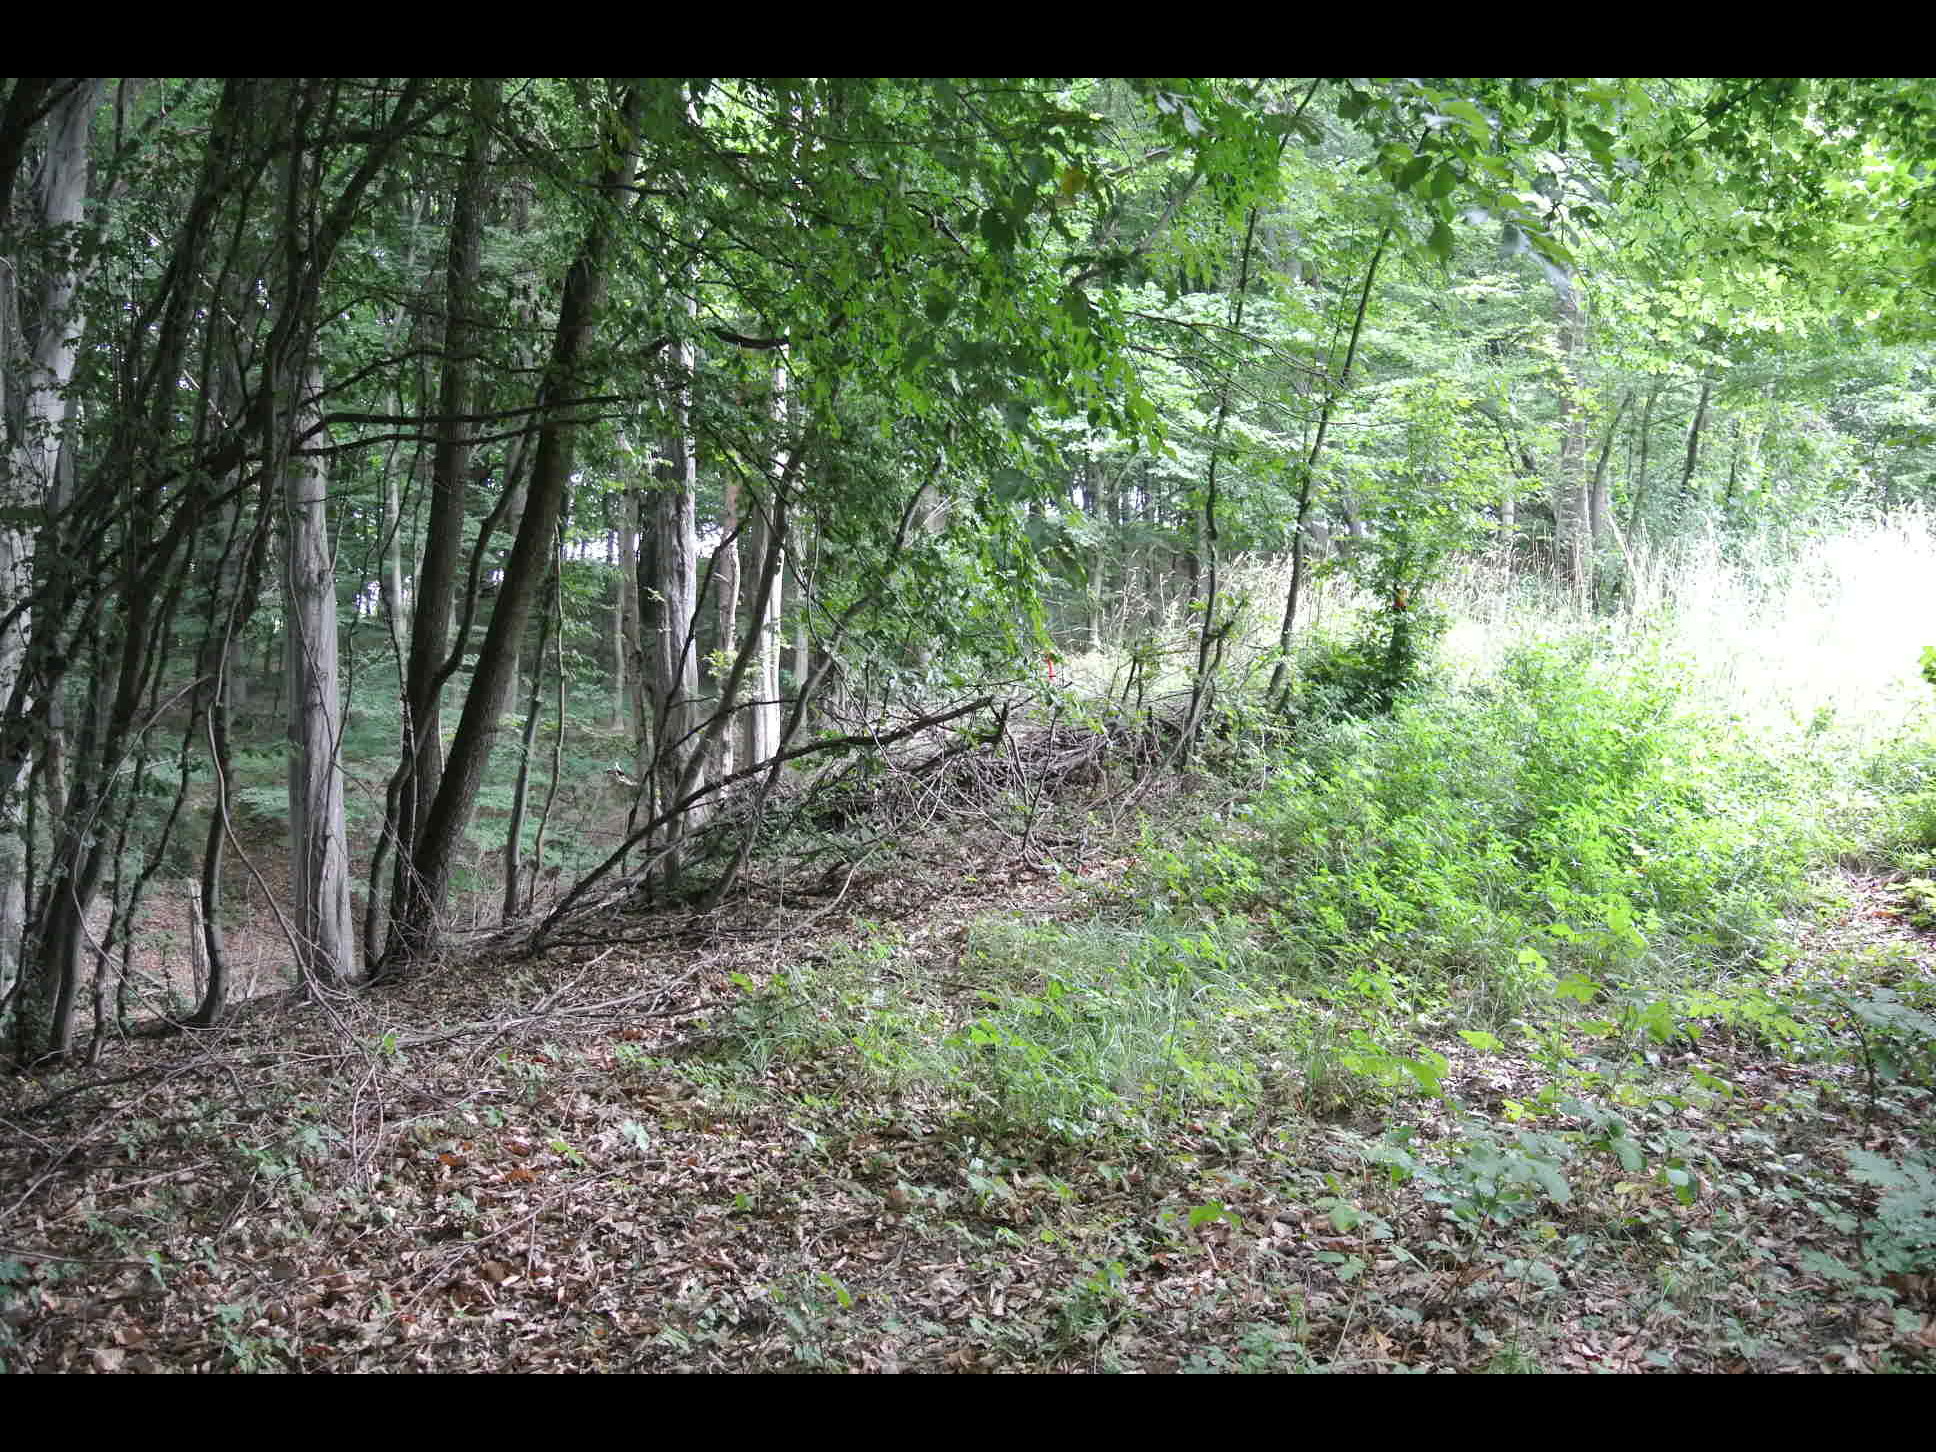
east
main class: Woodland
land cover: Broadleaved woodland
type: beech forest
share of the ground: > 75 %
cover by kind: broadleaved forest trees 100 %
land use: Forestry
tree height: > 5 m
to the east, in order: Broadleaved woodland; Tracks; Grassland without tree/shrub cover
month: July
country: AT
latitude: 47.6221
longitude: 16.4040
